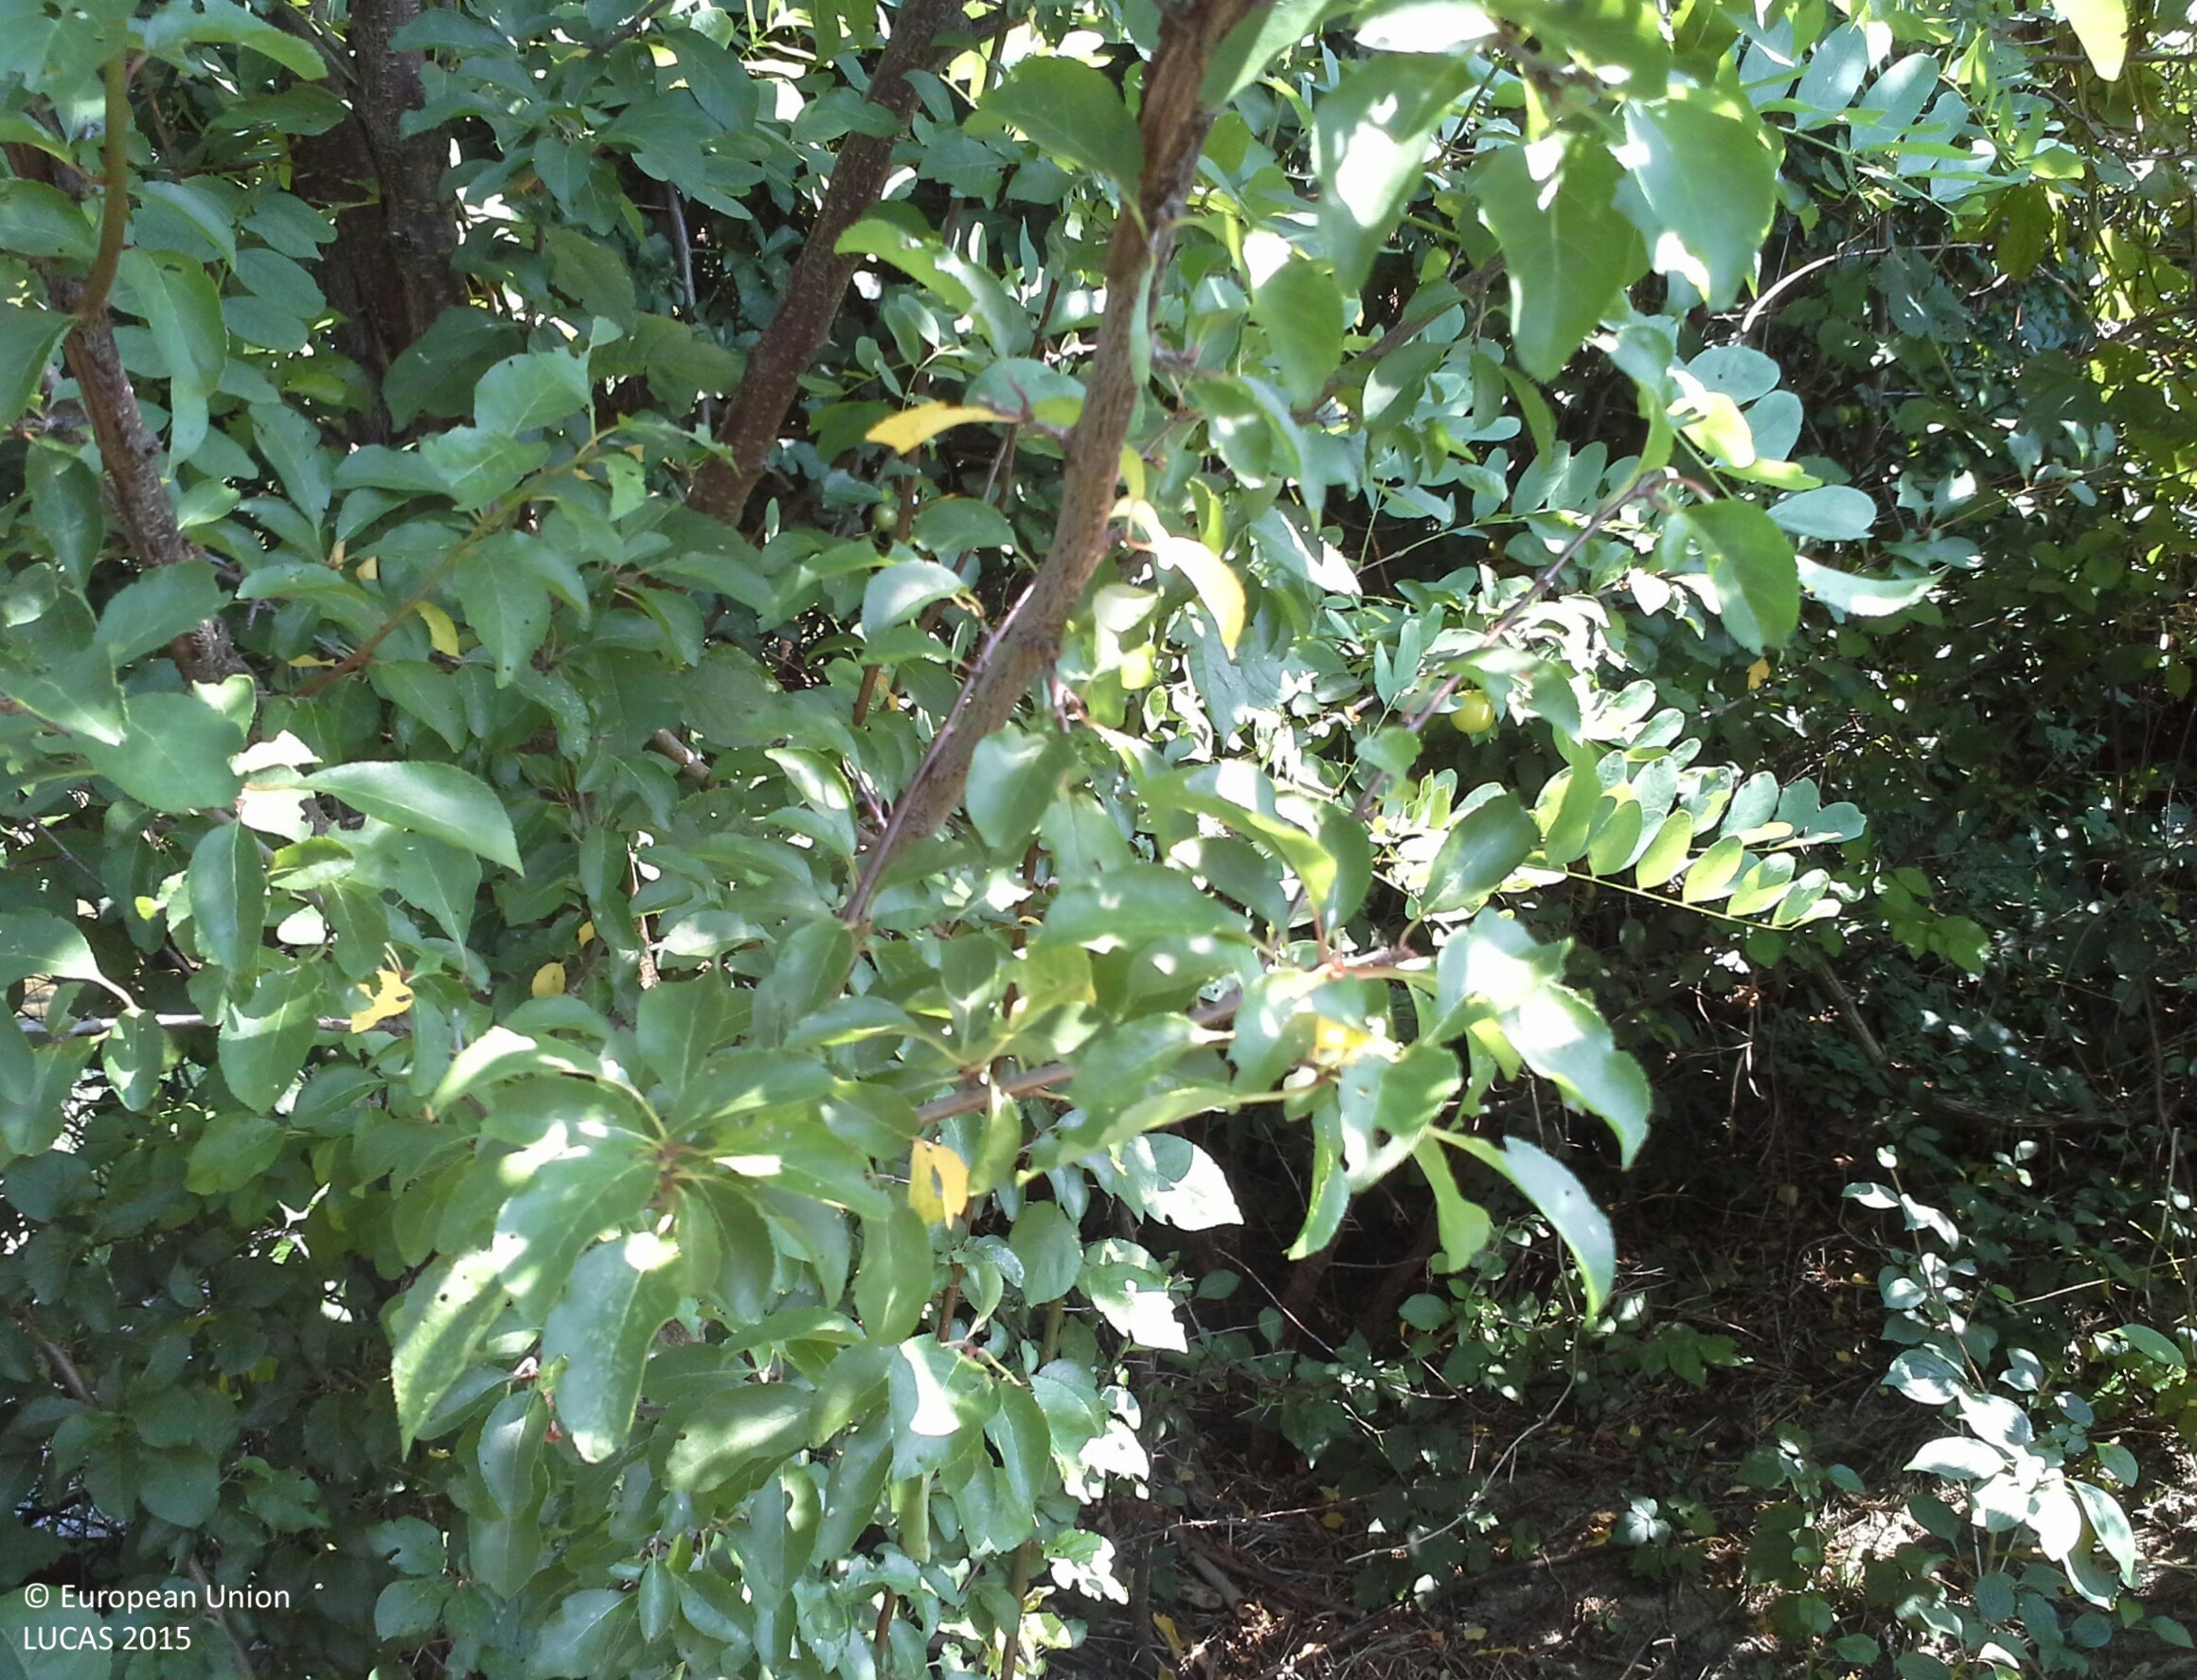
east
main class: Woodland
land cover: Broadleaved woodland
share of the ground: 50 - 75 %
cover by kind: broadleaved forest trees 60 %, shrubs 20 %, herbaceous plants 20 %
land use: Semi-natural and natural areas not in use
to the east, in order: Broadleaved woodland; Inland fresh running water; Broadleaved woodland; Maize; Tracks; Broadleaved woodland; Grass margins; Inland fresh running water; Shrubland with sparse tree cover; Barley
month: July
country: AT
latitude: 48.0546
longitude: 15.0323
